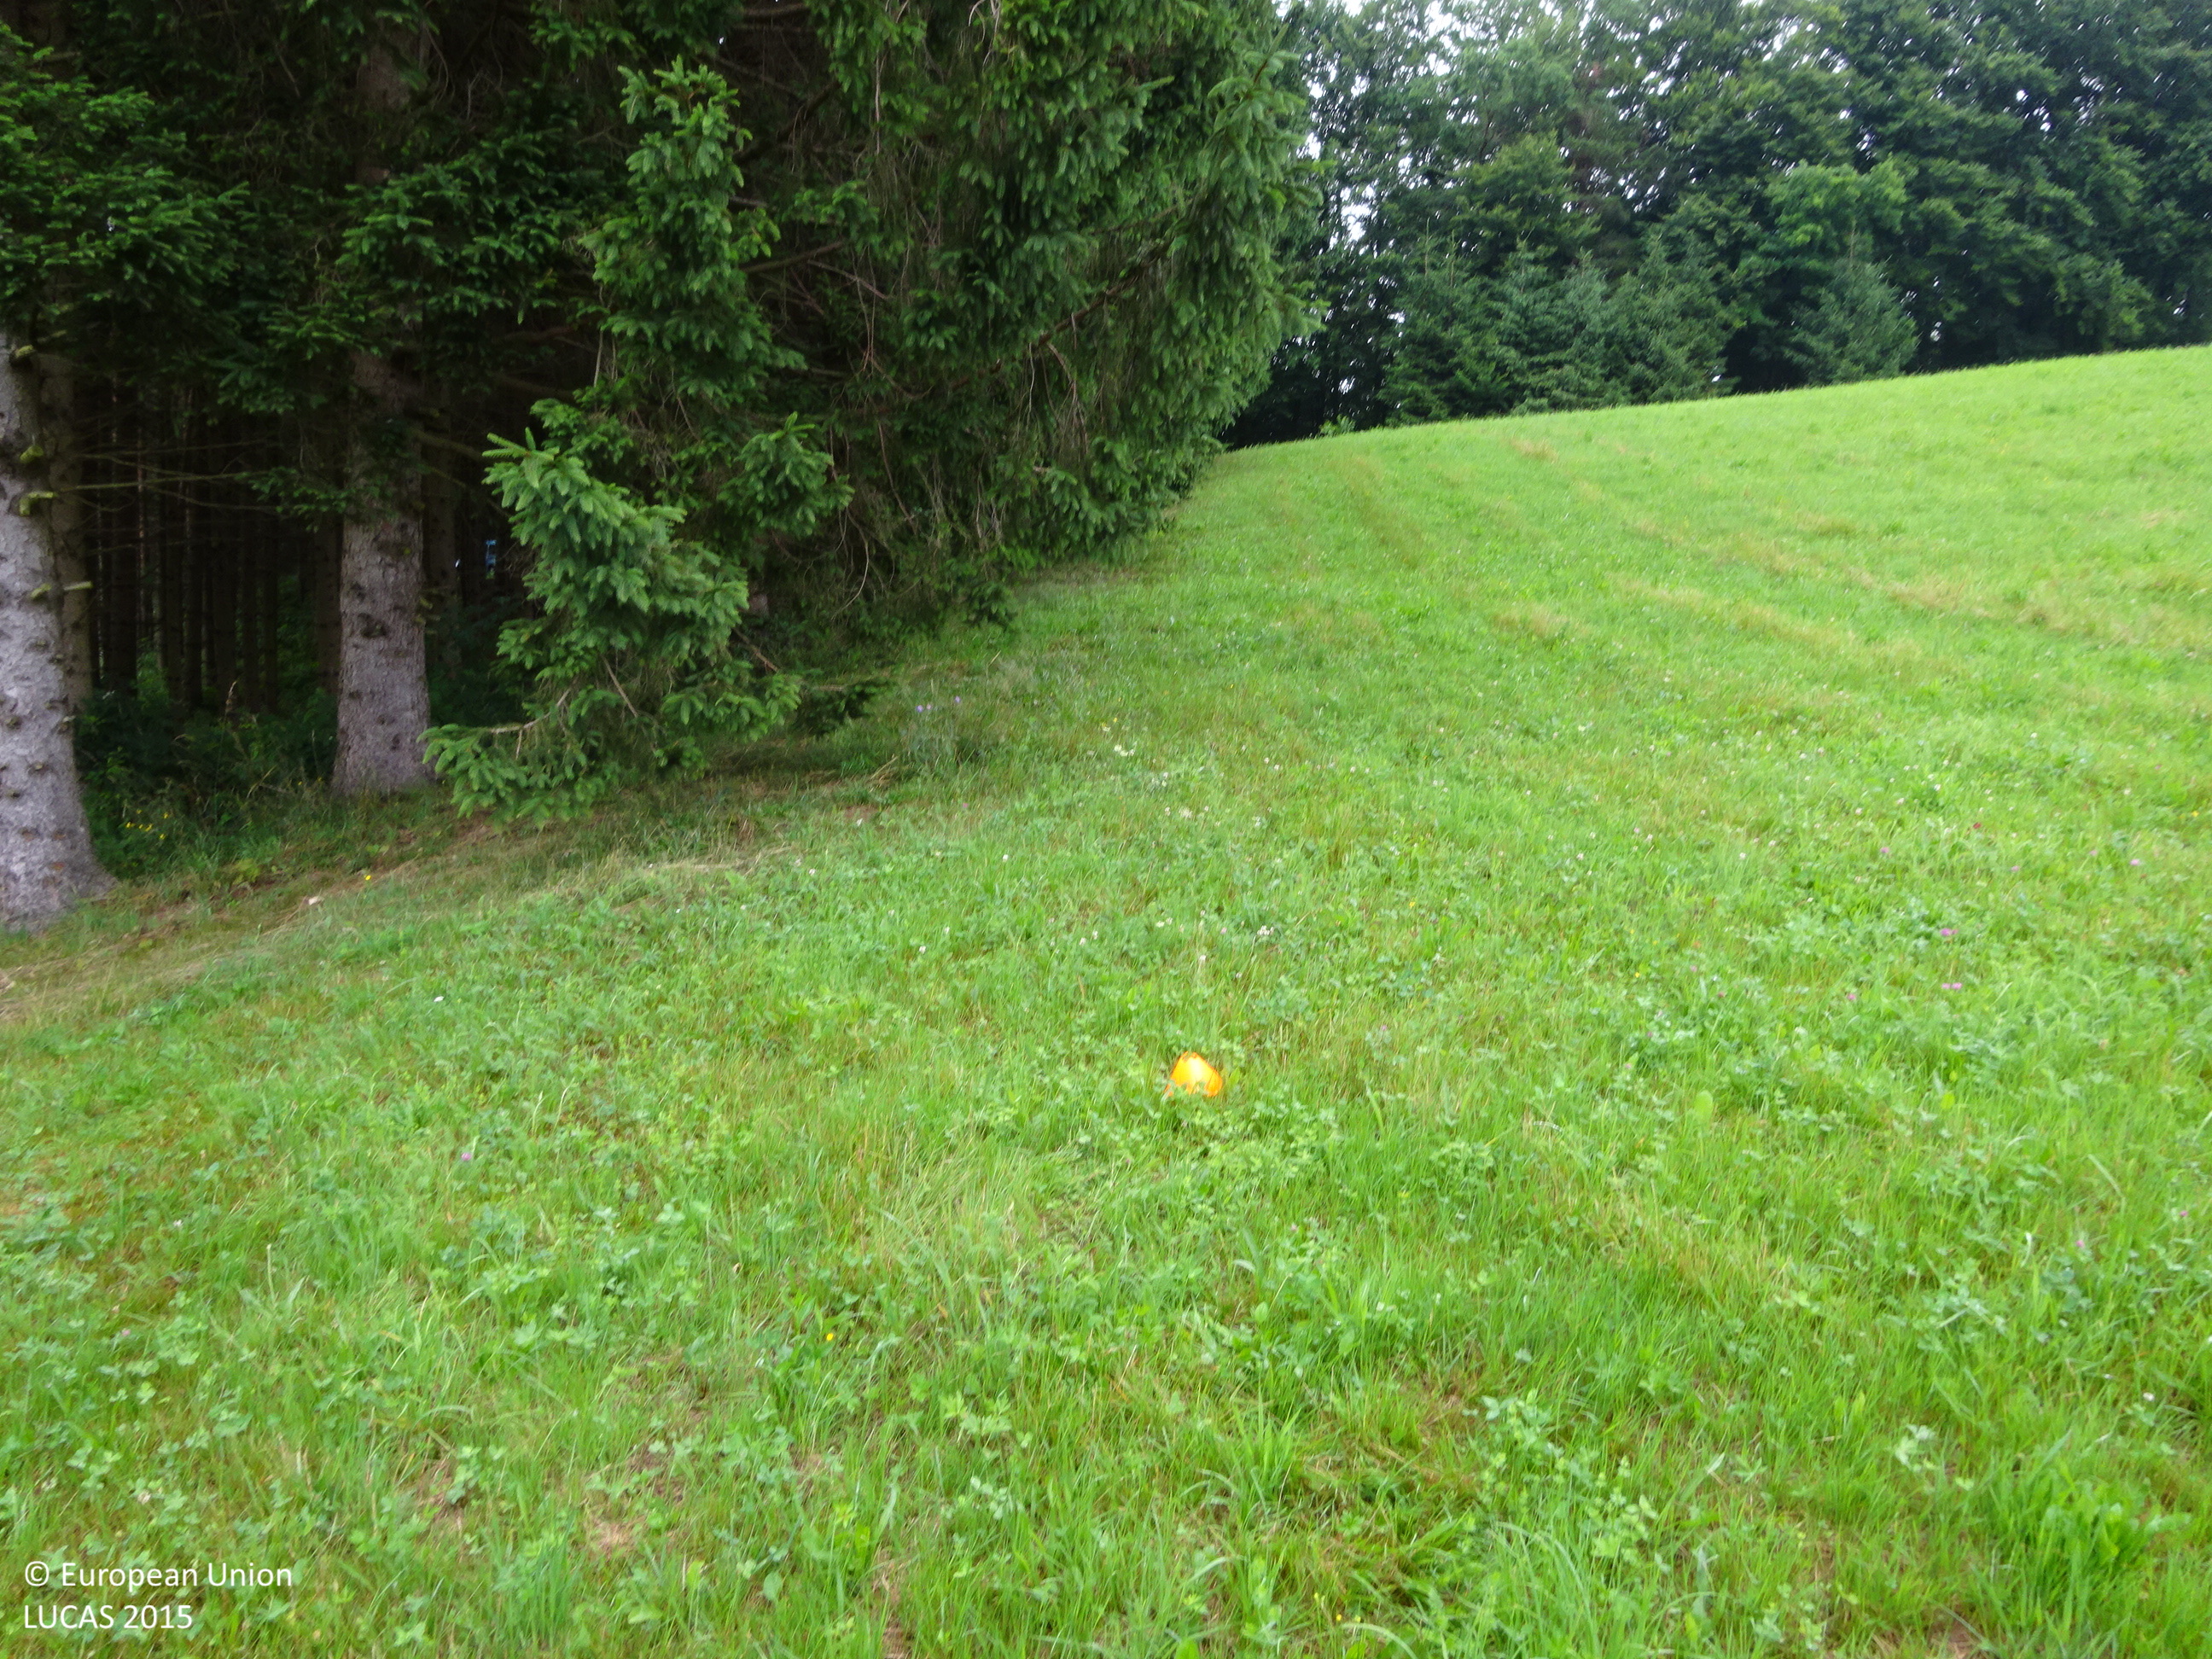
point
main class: Grassland
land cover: Grassland without tree/shrub cover
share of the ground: > 75 %
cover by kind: herbaceous plants 100 %
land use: Agriculture (excluding fallow land and kitchen gardens)
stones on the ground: < 10 %
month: June
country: AT
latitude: 46.7393
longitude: 15.3781
